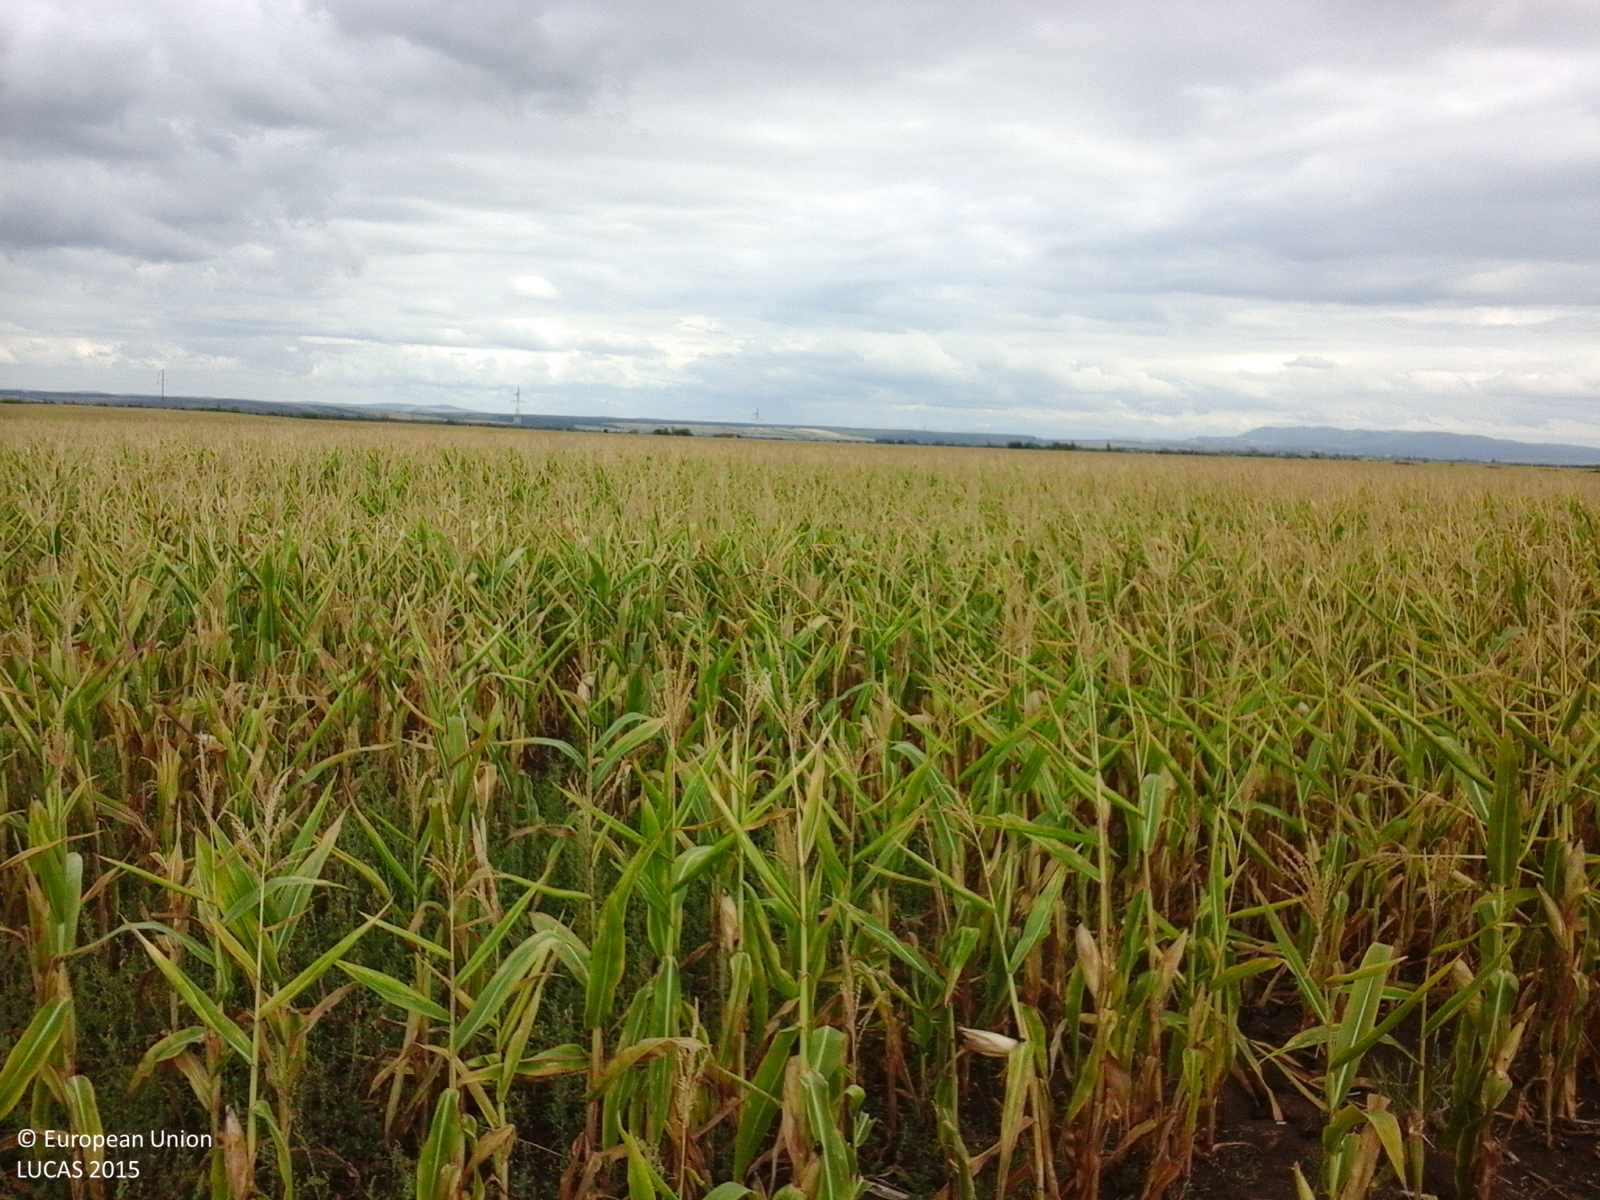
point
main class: Cropland
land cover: Maize
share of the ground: > 75 %
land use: Agriculture (excluding fallow land and kitchen gardens)
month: August
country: RO
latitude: 45.4173
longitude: 21.5203
